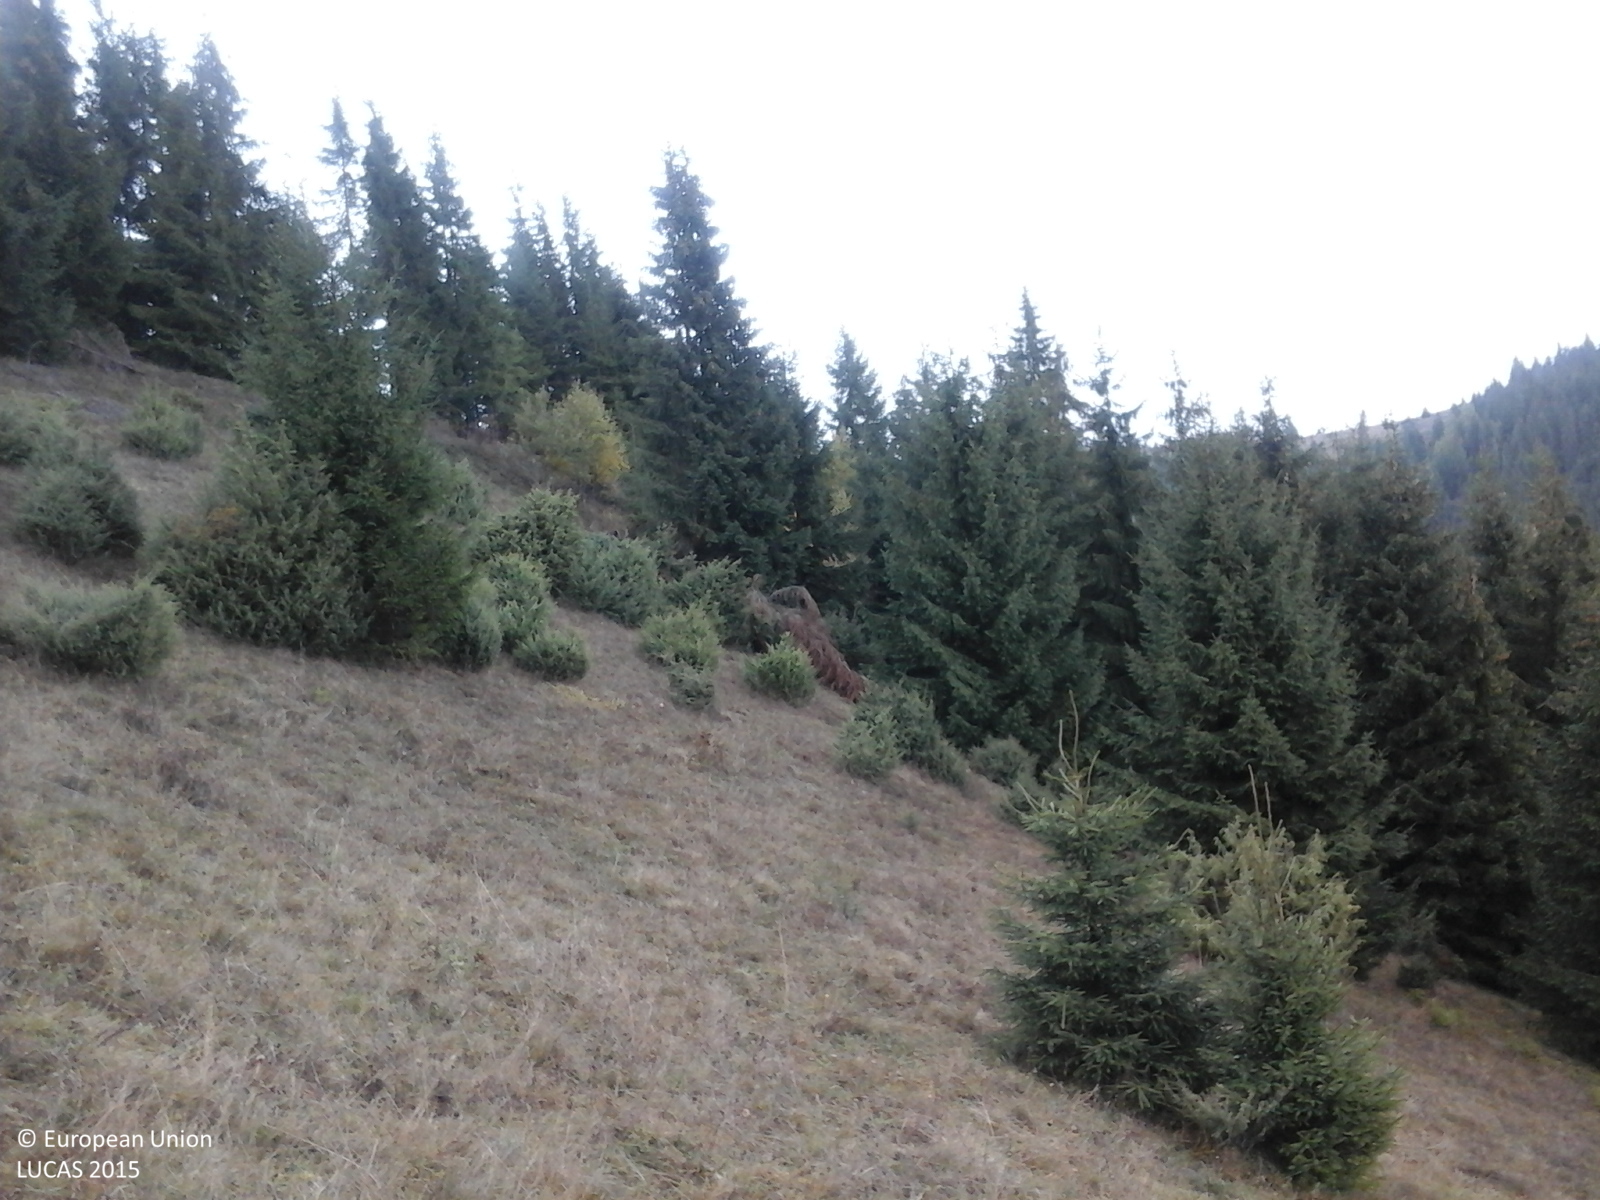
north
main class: Grassland
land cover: Grassland with sparse tree/shrub cover
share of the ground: > 75 %
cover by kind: herbaceous plants 95 %, coniferous forest trees 5 %
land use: Agriculture (excluding fallow land and kitchen gardens)
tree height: > 5 m
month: October
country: RO
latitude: 46.8798
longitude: 25.5036
